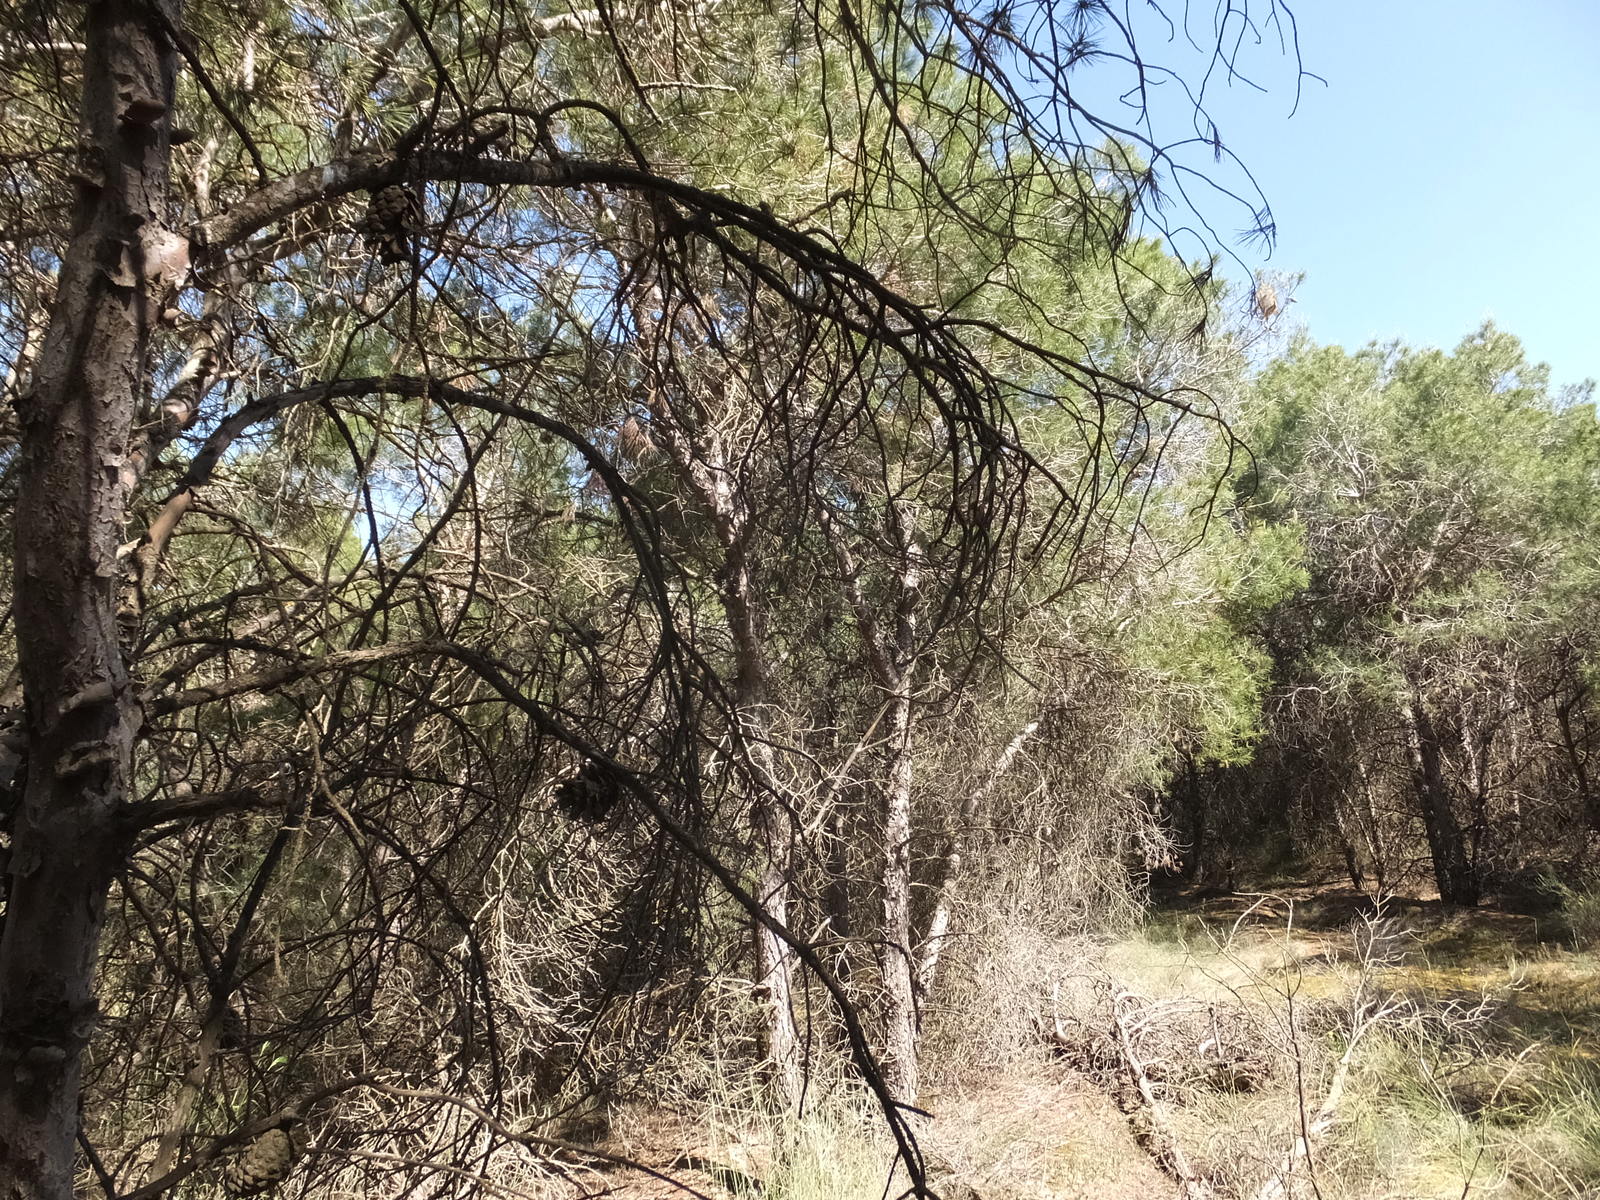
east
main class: Woodland
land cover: Pine dominated mixed woodland
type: coniferous forest of the mediterranean region
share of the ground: > 75 %
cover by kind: coniferous forest trees 50 %, broadleaved forest trees 25 %, herbaceous plants 25 %
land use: Forestry
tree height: > 5 m
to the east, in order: Pine dominated mixed woodland; Grassland with sparse tree/shrub cover; Tracks; Lucerne; Shruby margins; Single bushes/trees; Common wheat
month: May
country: ES
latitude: 41.6845
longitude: 0.3630
